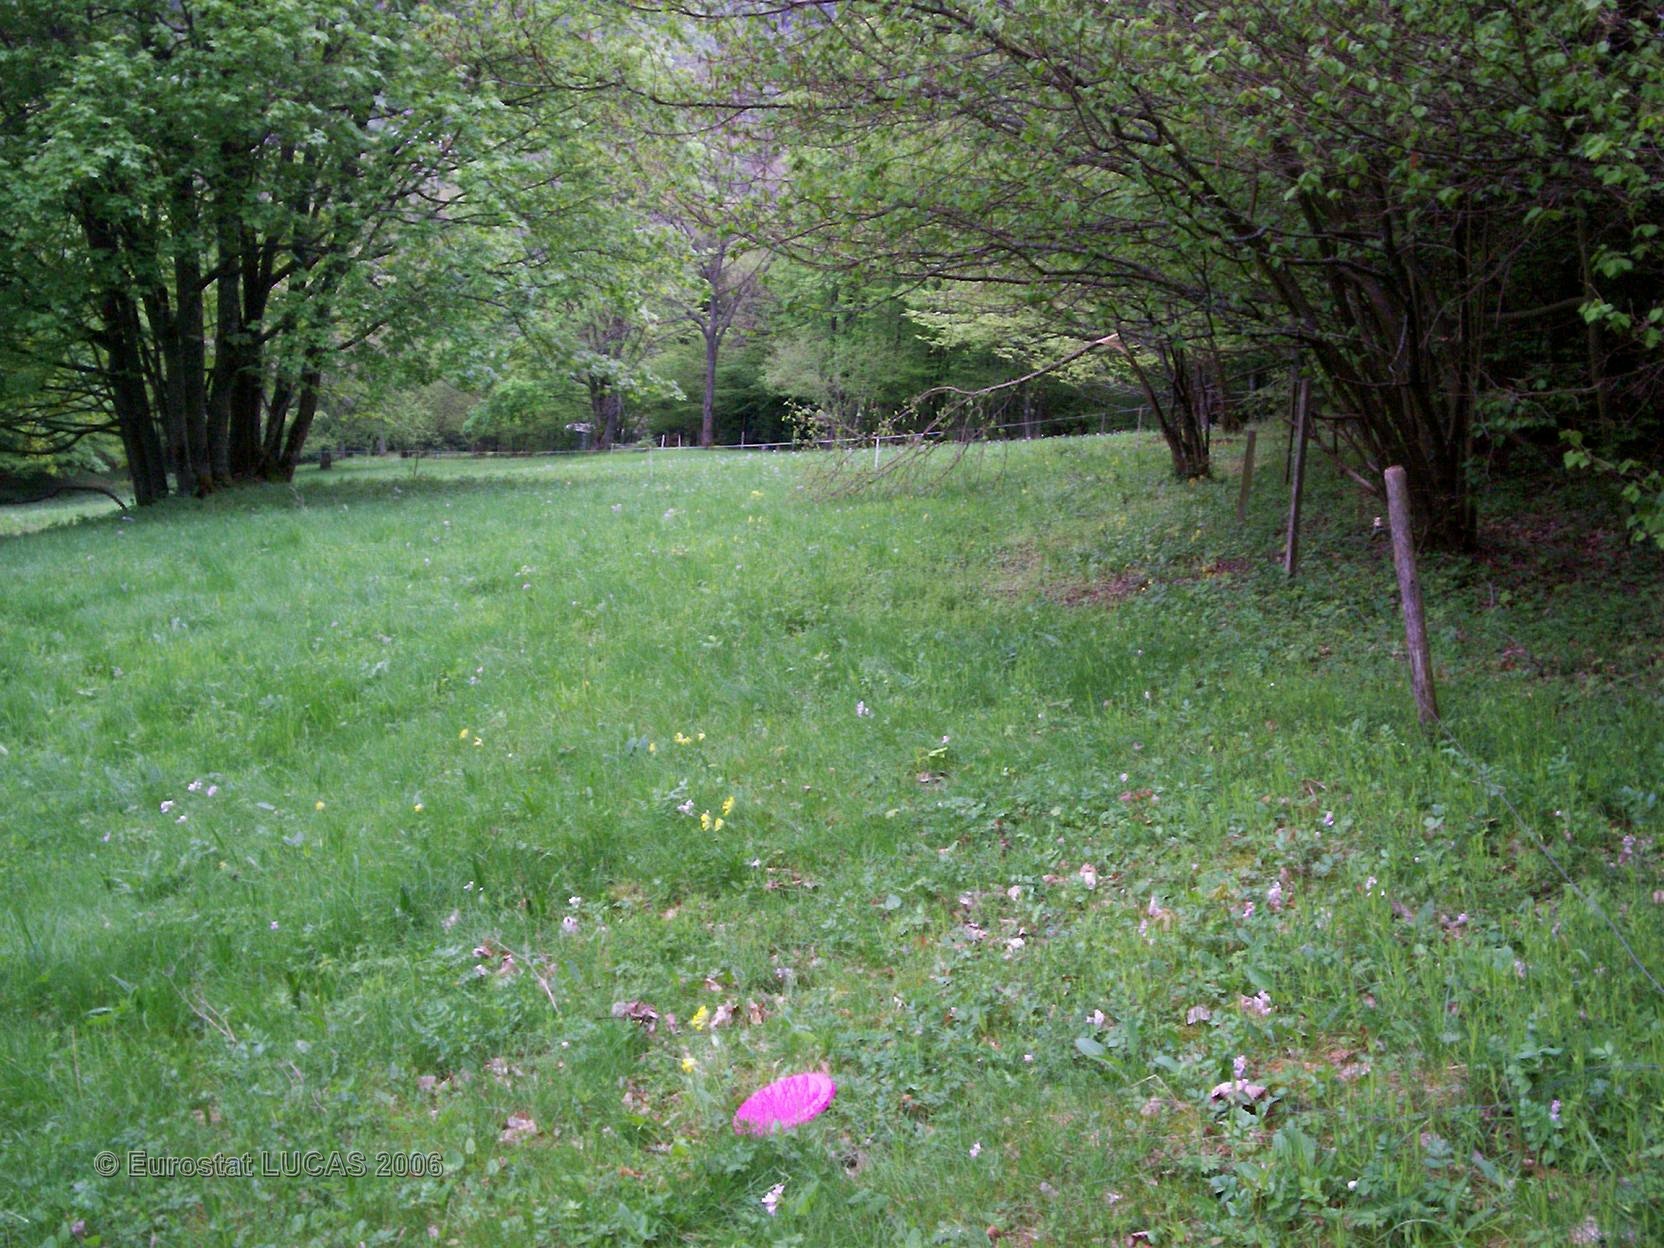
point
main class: Grassland
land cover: Grassland with sparse tree/shrub cover
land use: Agriculture (excluding fallow land and kitchen gardens)
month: May
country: FR
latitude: 47.8987
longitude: 7.1521
